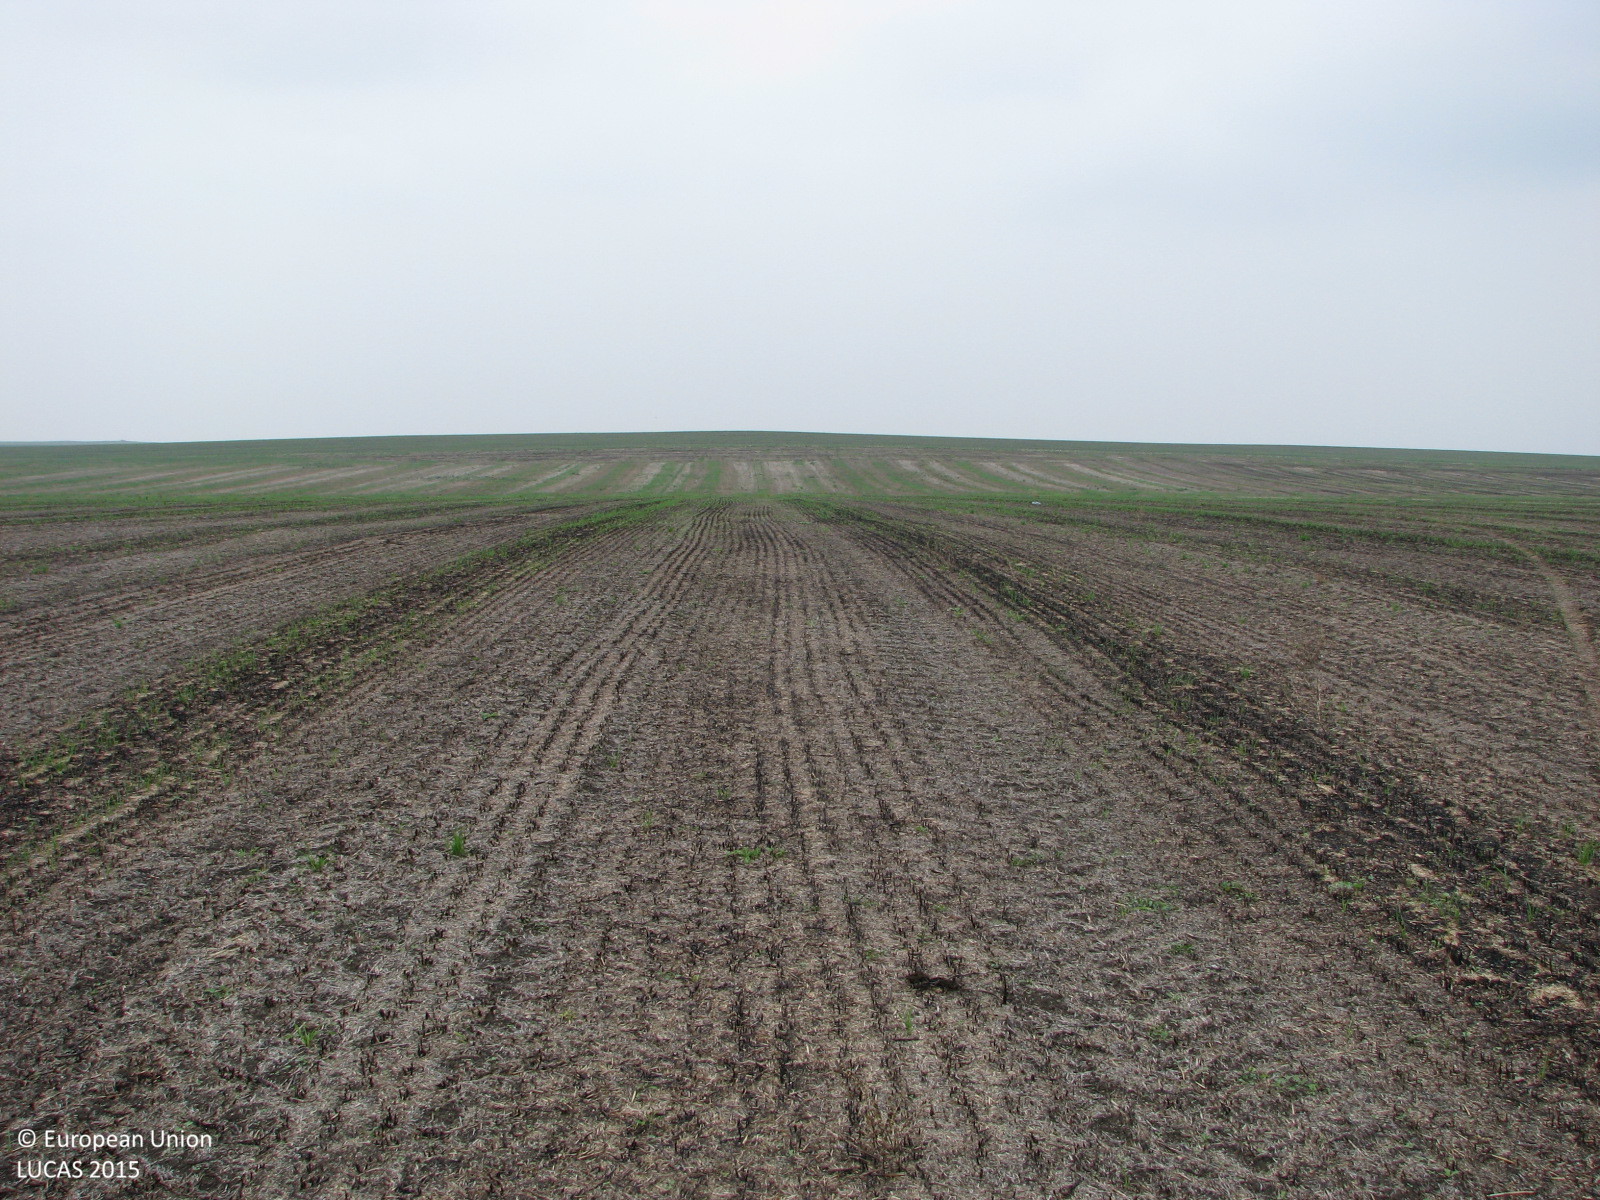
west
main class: Cropland
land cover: Common wheat
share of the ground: 10 - 25 %
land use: Agriculture (excluding fallow land and kitchen gardens)
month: October
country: BG
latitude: 42.3557
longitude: 26.6166
